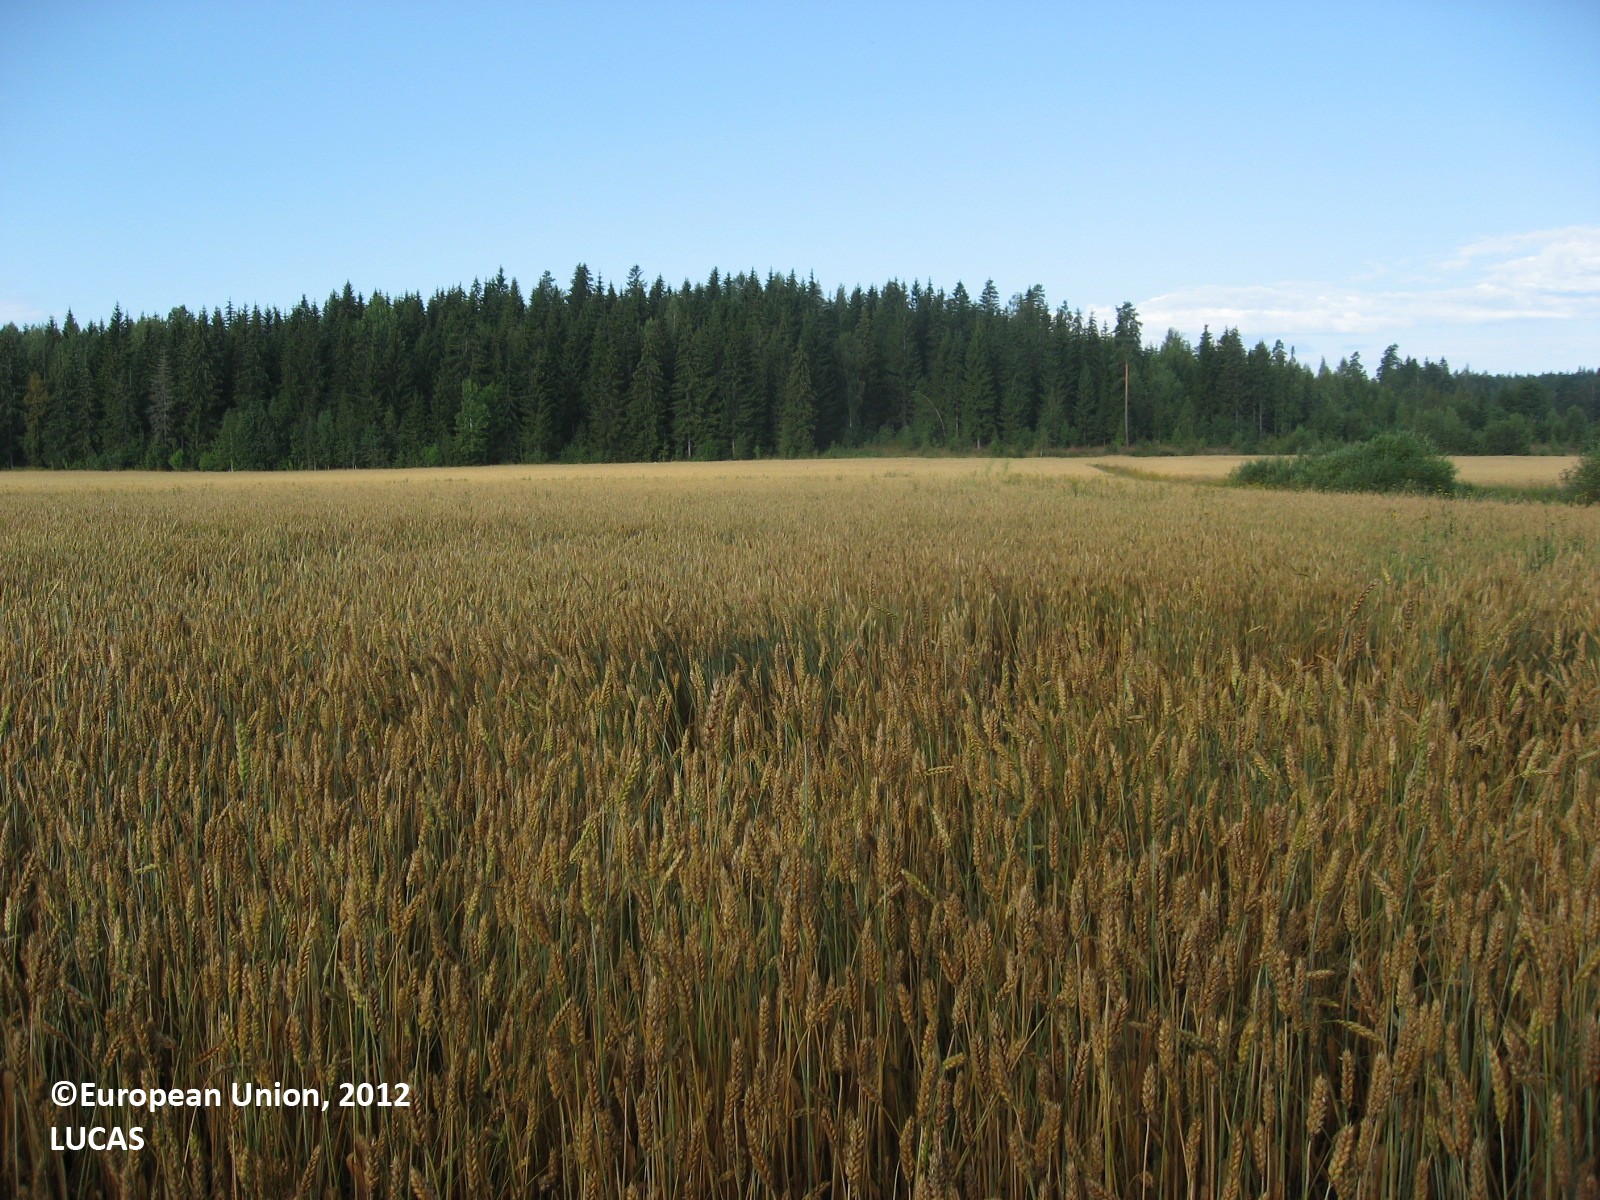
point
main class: Cropland
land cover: Common wheat
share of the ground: > 75 %
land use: Agriculture (excluding fallow land and kitchen gardens)
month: August
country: FI
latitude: 60.6404
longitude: 25.1685
